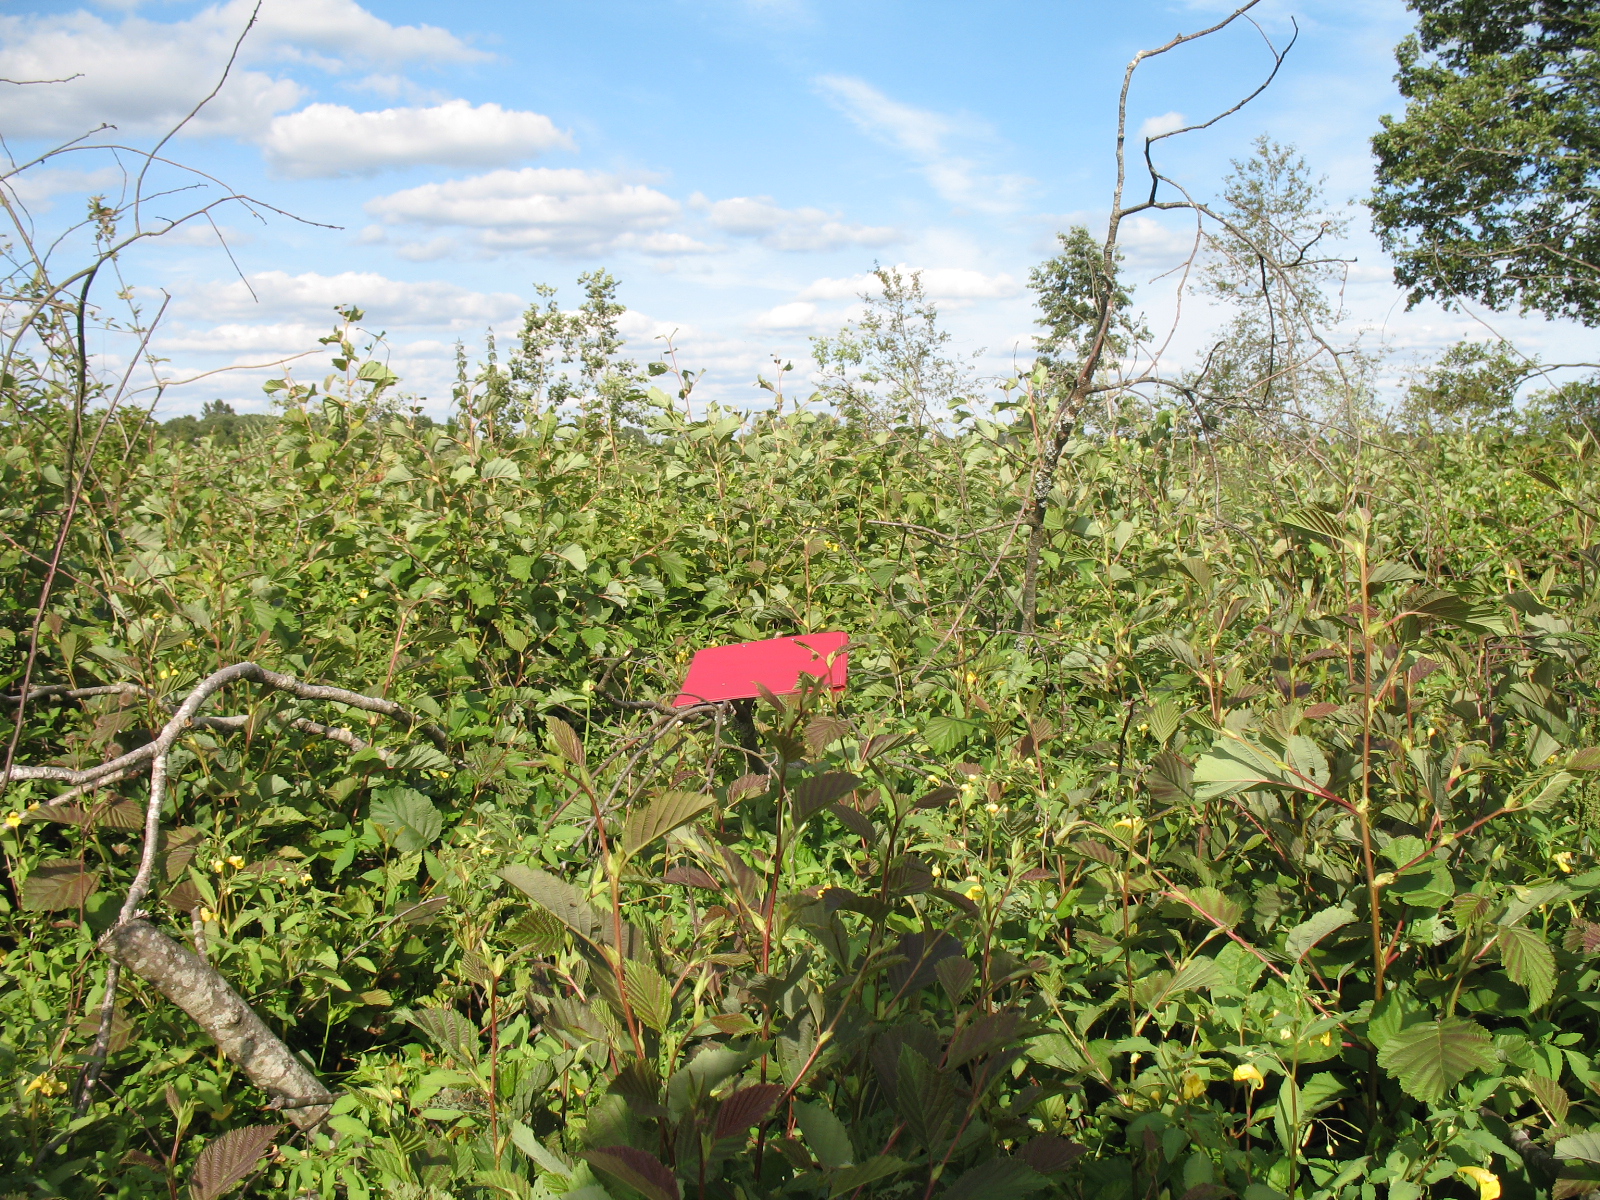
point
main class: Woodland
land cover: Broadleaved woodland
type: non-riverine alder, birch or aspen forest
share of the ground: 50 - 75 %
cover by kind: broadleaved forest trees 60 %, herbaceous plants 40 %
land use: Forestry
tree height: < 5 m
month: July
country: LV
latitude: 56.2712
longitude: 25.1461
